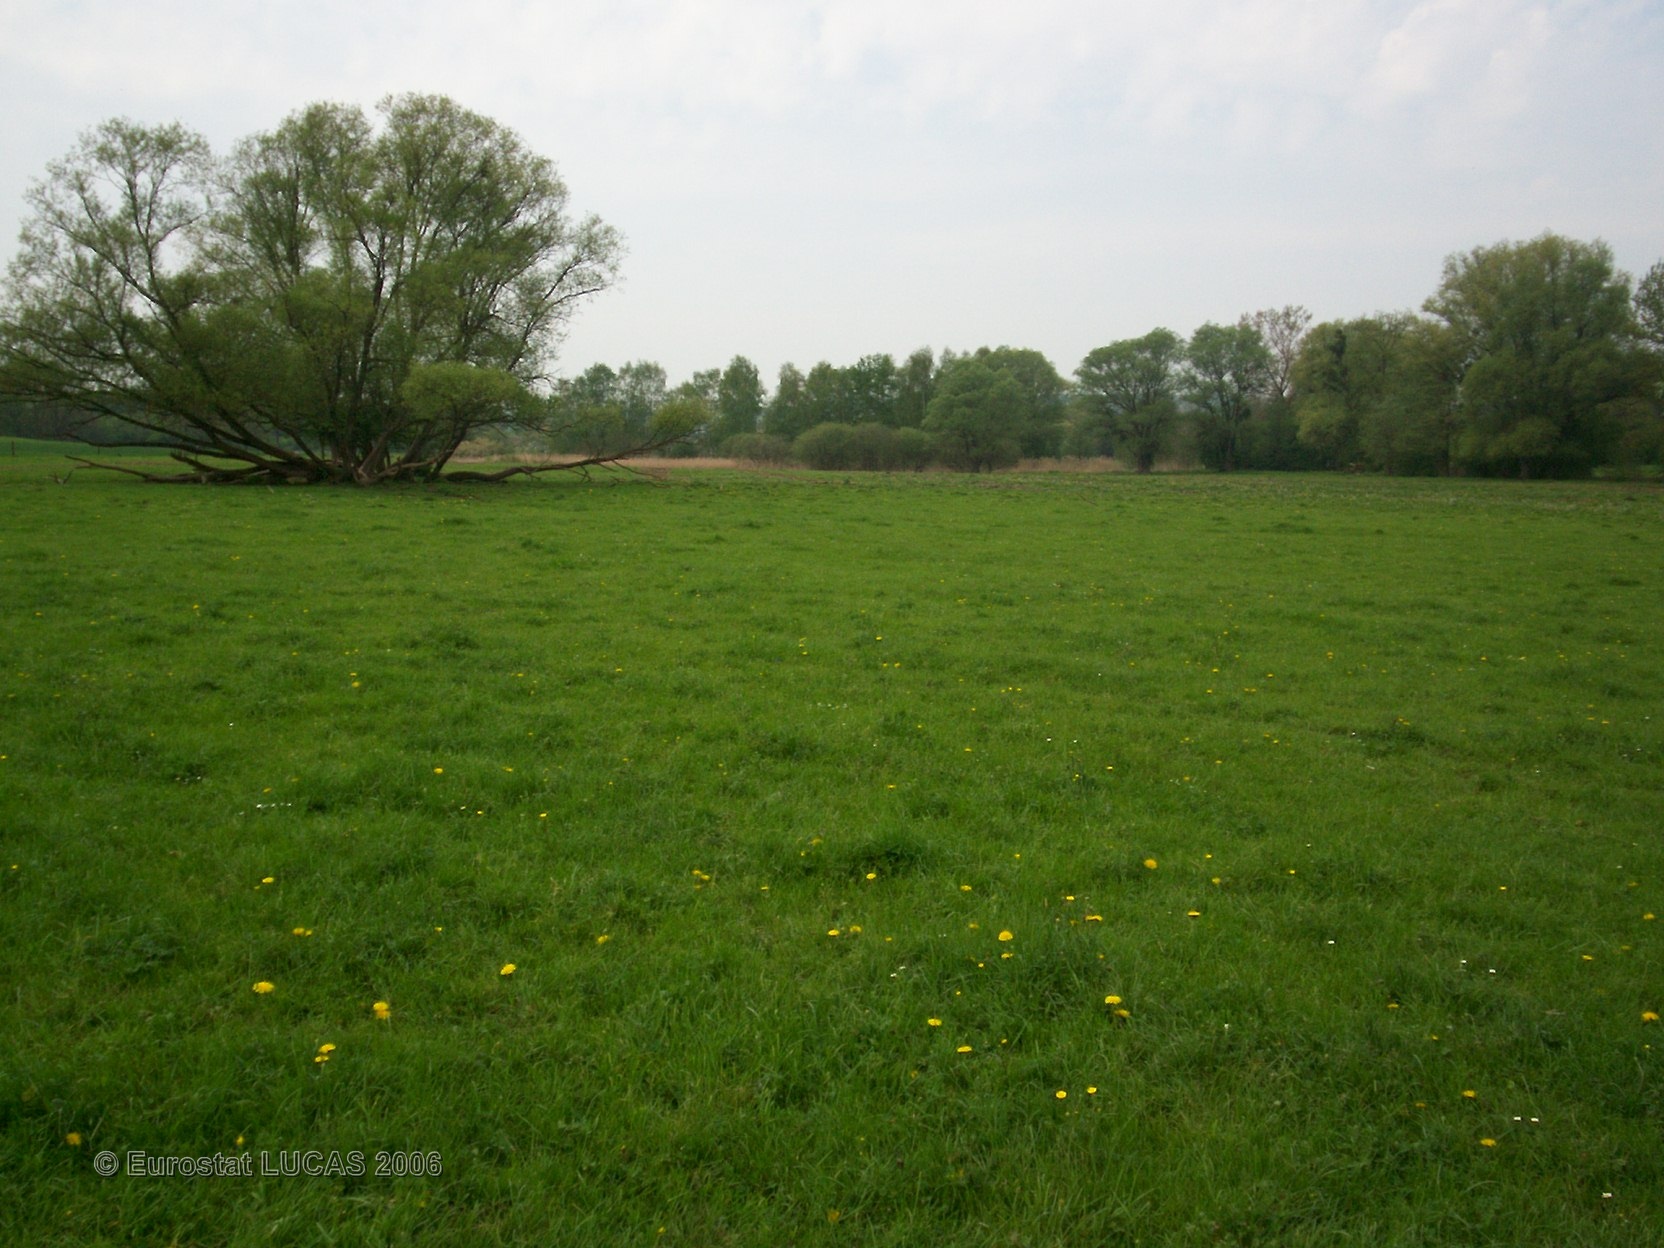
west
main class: Grassland
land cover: Grassland without tree/shrub cover
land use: Agriculture (excluding fallow land and kitchen gardens)
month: May
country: FR
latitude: 49.2287
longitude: 6.4433
